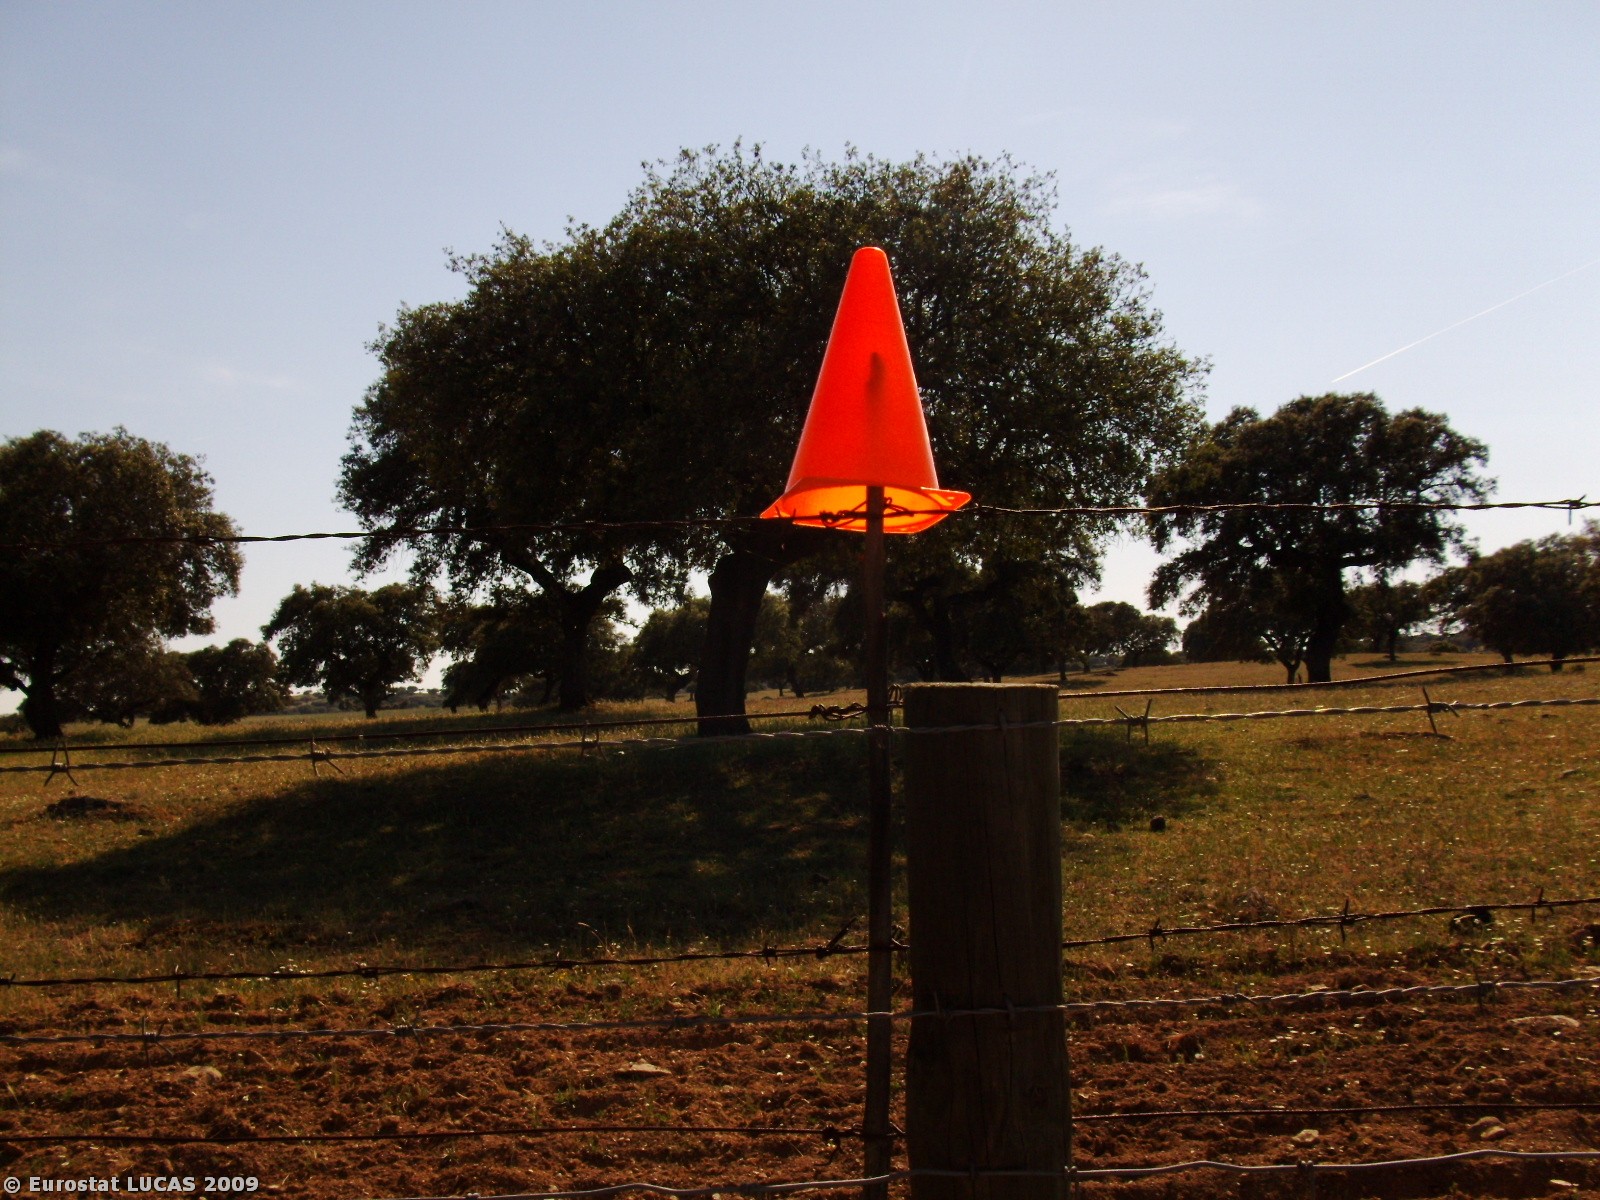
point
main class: Woodland
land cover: Broadleaved woodland
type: broadleaved evergreen forest
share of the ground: 25 - 50 %
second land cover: Spontaneously vegetated surfaces
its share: 50 - 75 %
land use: Agriculture (excluding fallow land and kitchen gardens)
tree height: > 5 m
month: May
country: PT
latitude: 38.8028
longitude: -7.3372
